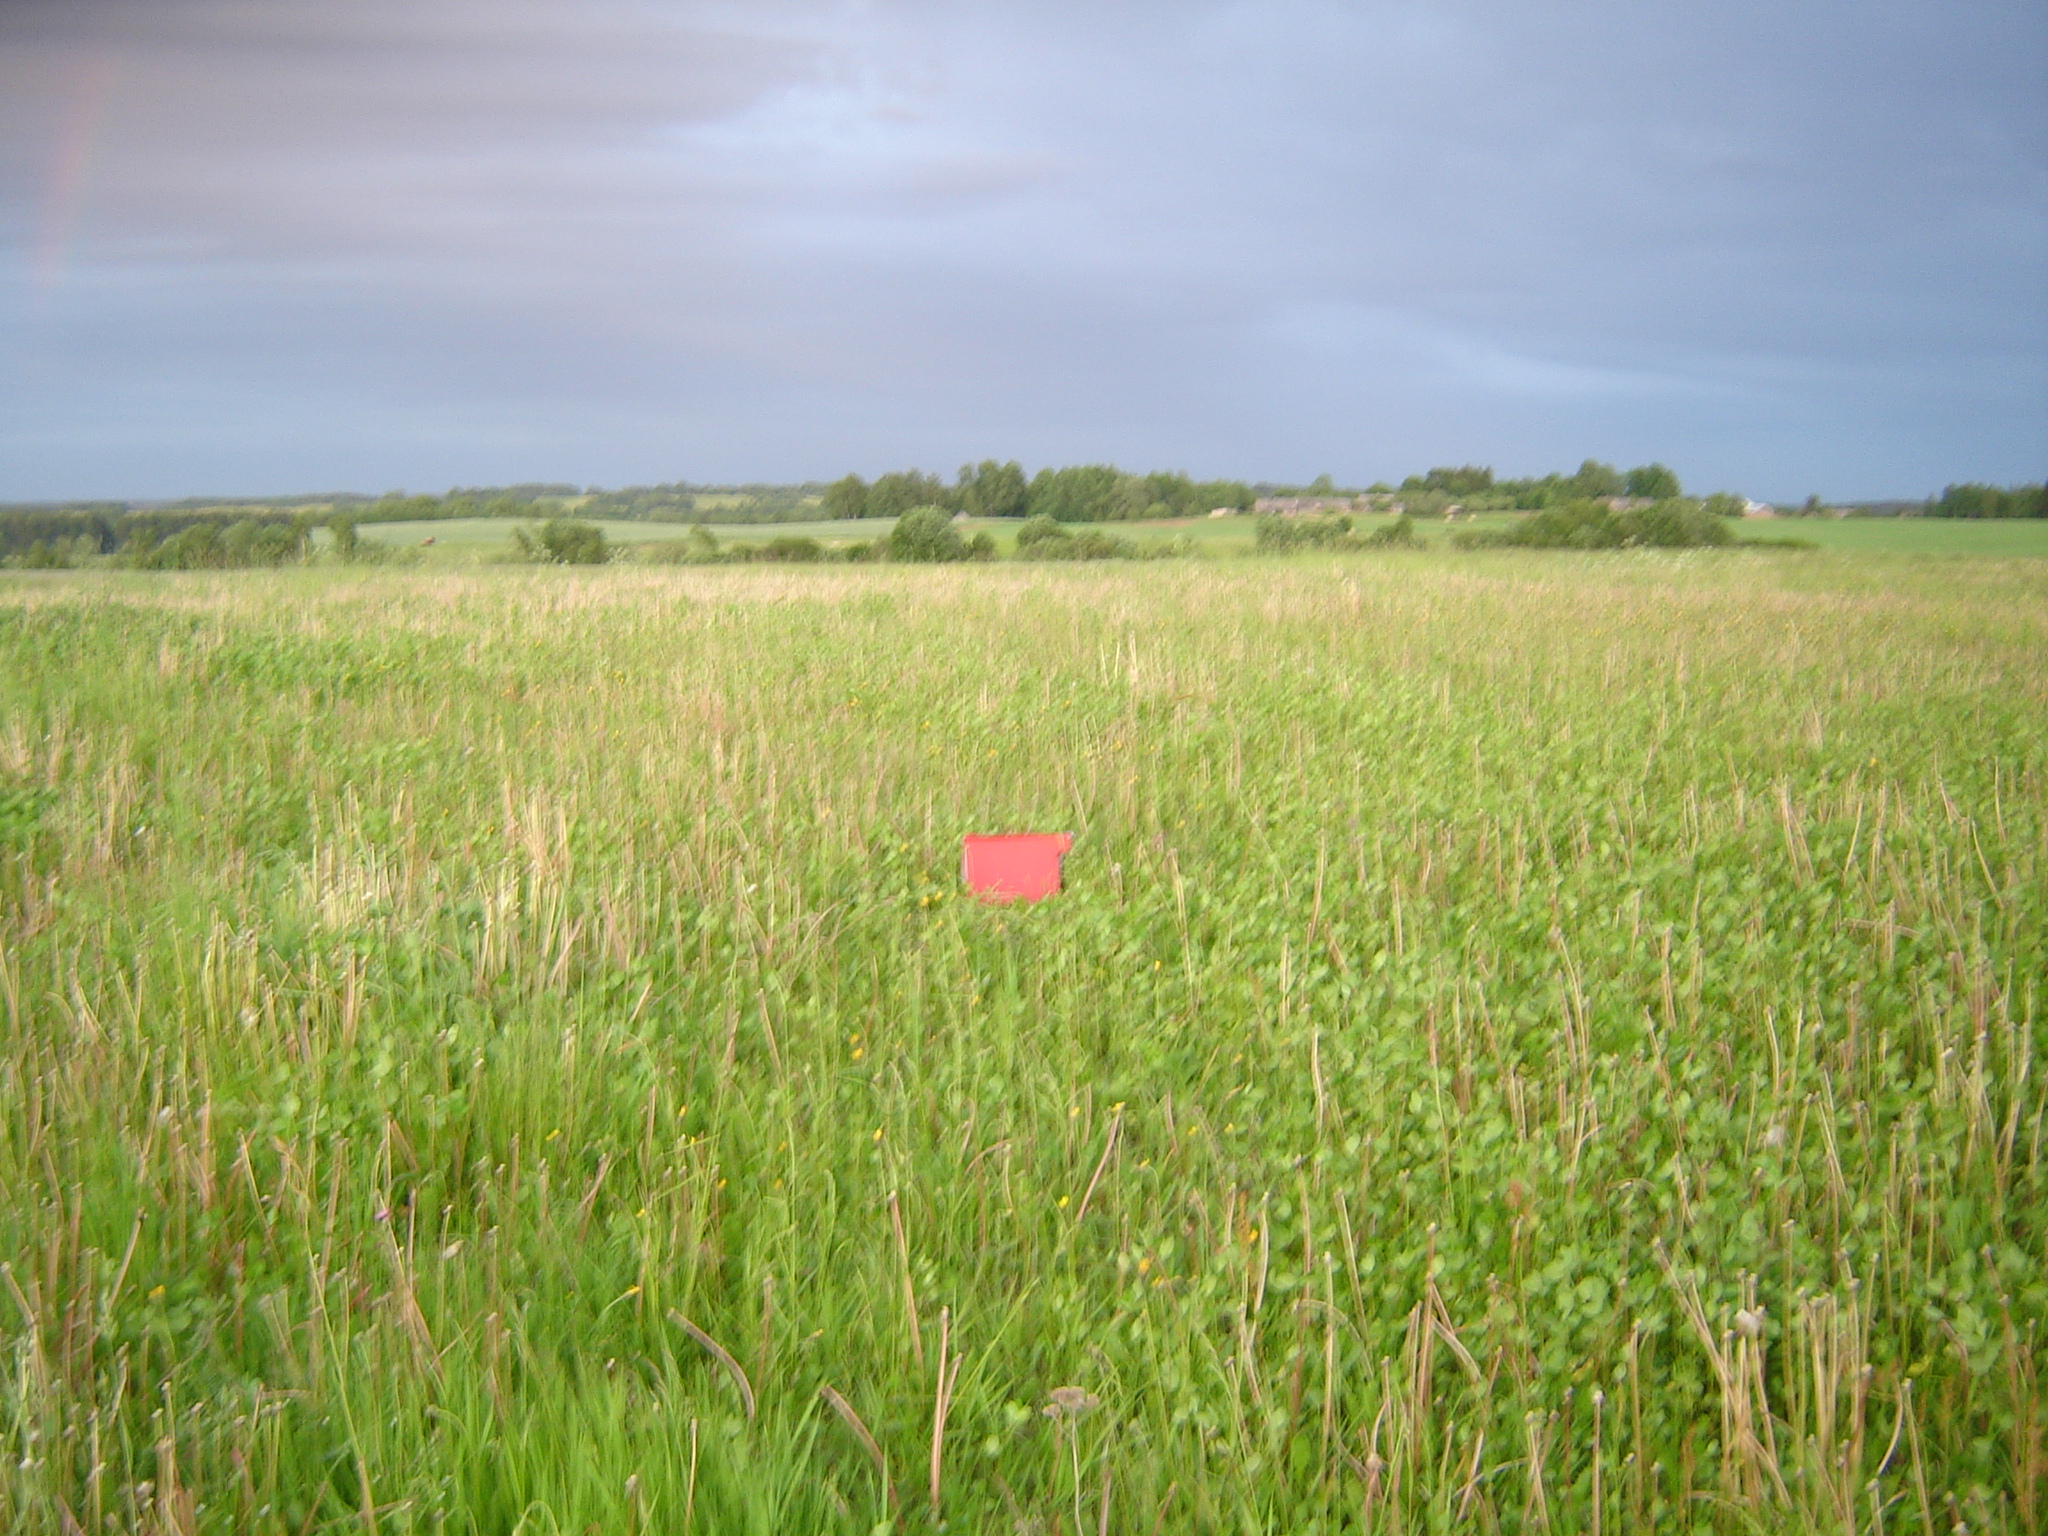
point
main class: Grassland
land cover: Grassland without tree/shrub cover
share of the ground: > 75 %
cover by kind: herbaceous plants 100 %
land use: Agriculture (excluding fallow land and kitchen gardens)
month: June
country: LT
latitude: 55.7632
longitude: 25.6993
